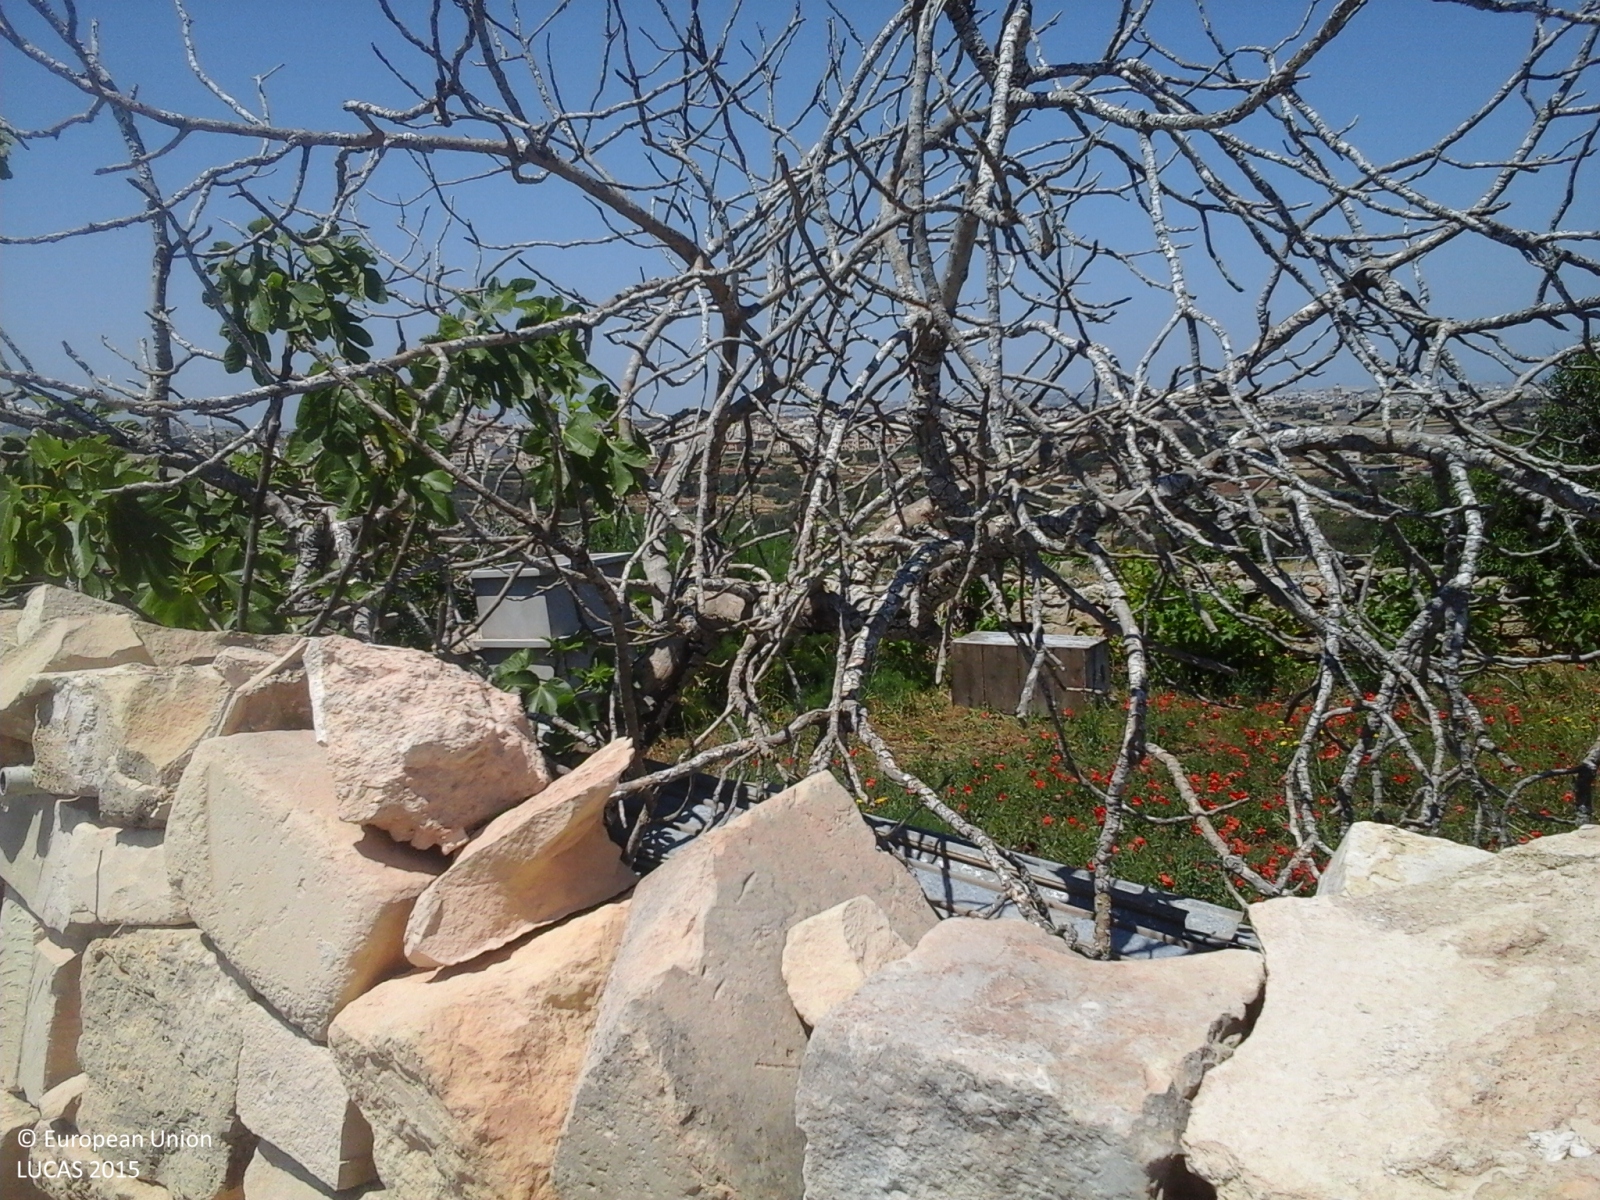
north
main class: Grassland
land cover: Spontaneously vegetated surfaces
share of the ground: 25 - 50 %
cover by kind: herbaceous plants 40 %, shrubs 5 %
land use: Agriculture (excluding fallow land and kitchen gardens)
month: May
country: MT
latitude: 35.8229
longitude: 14.4633
